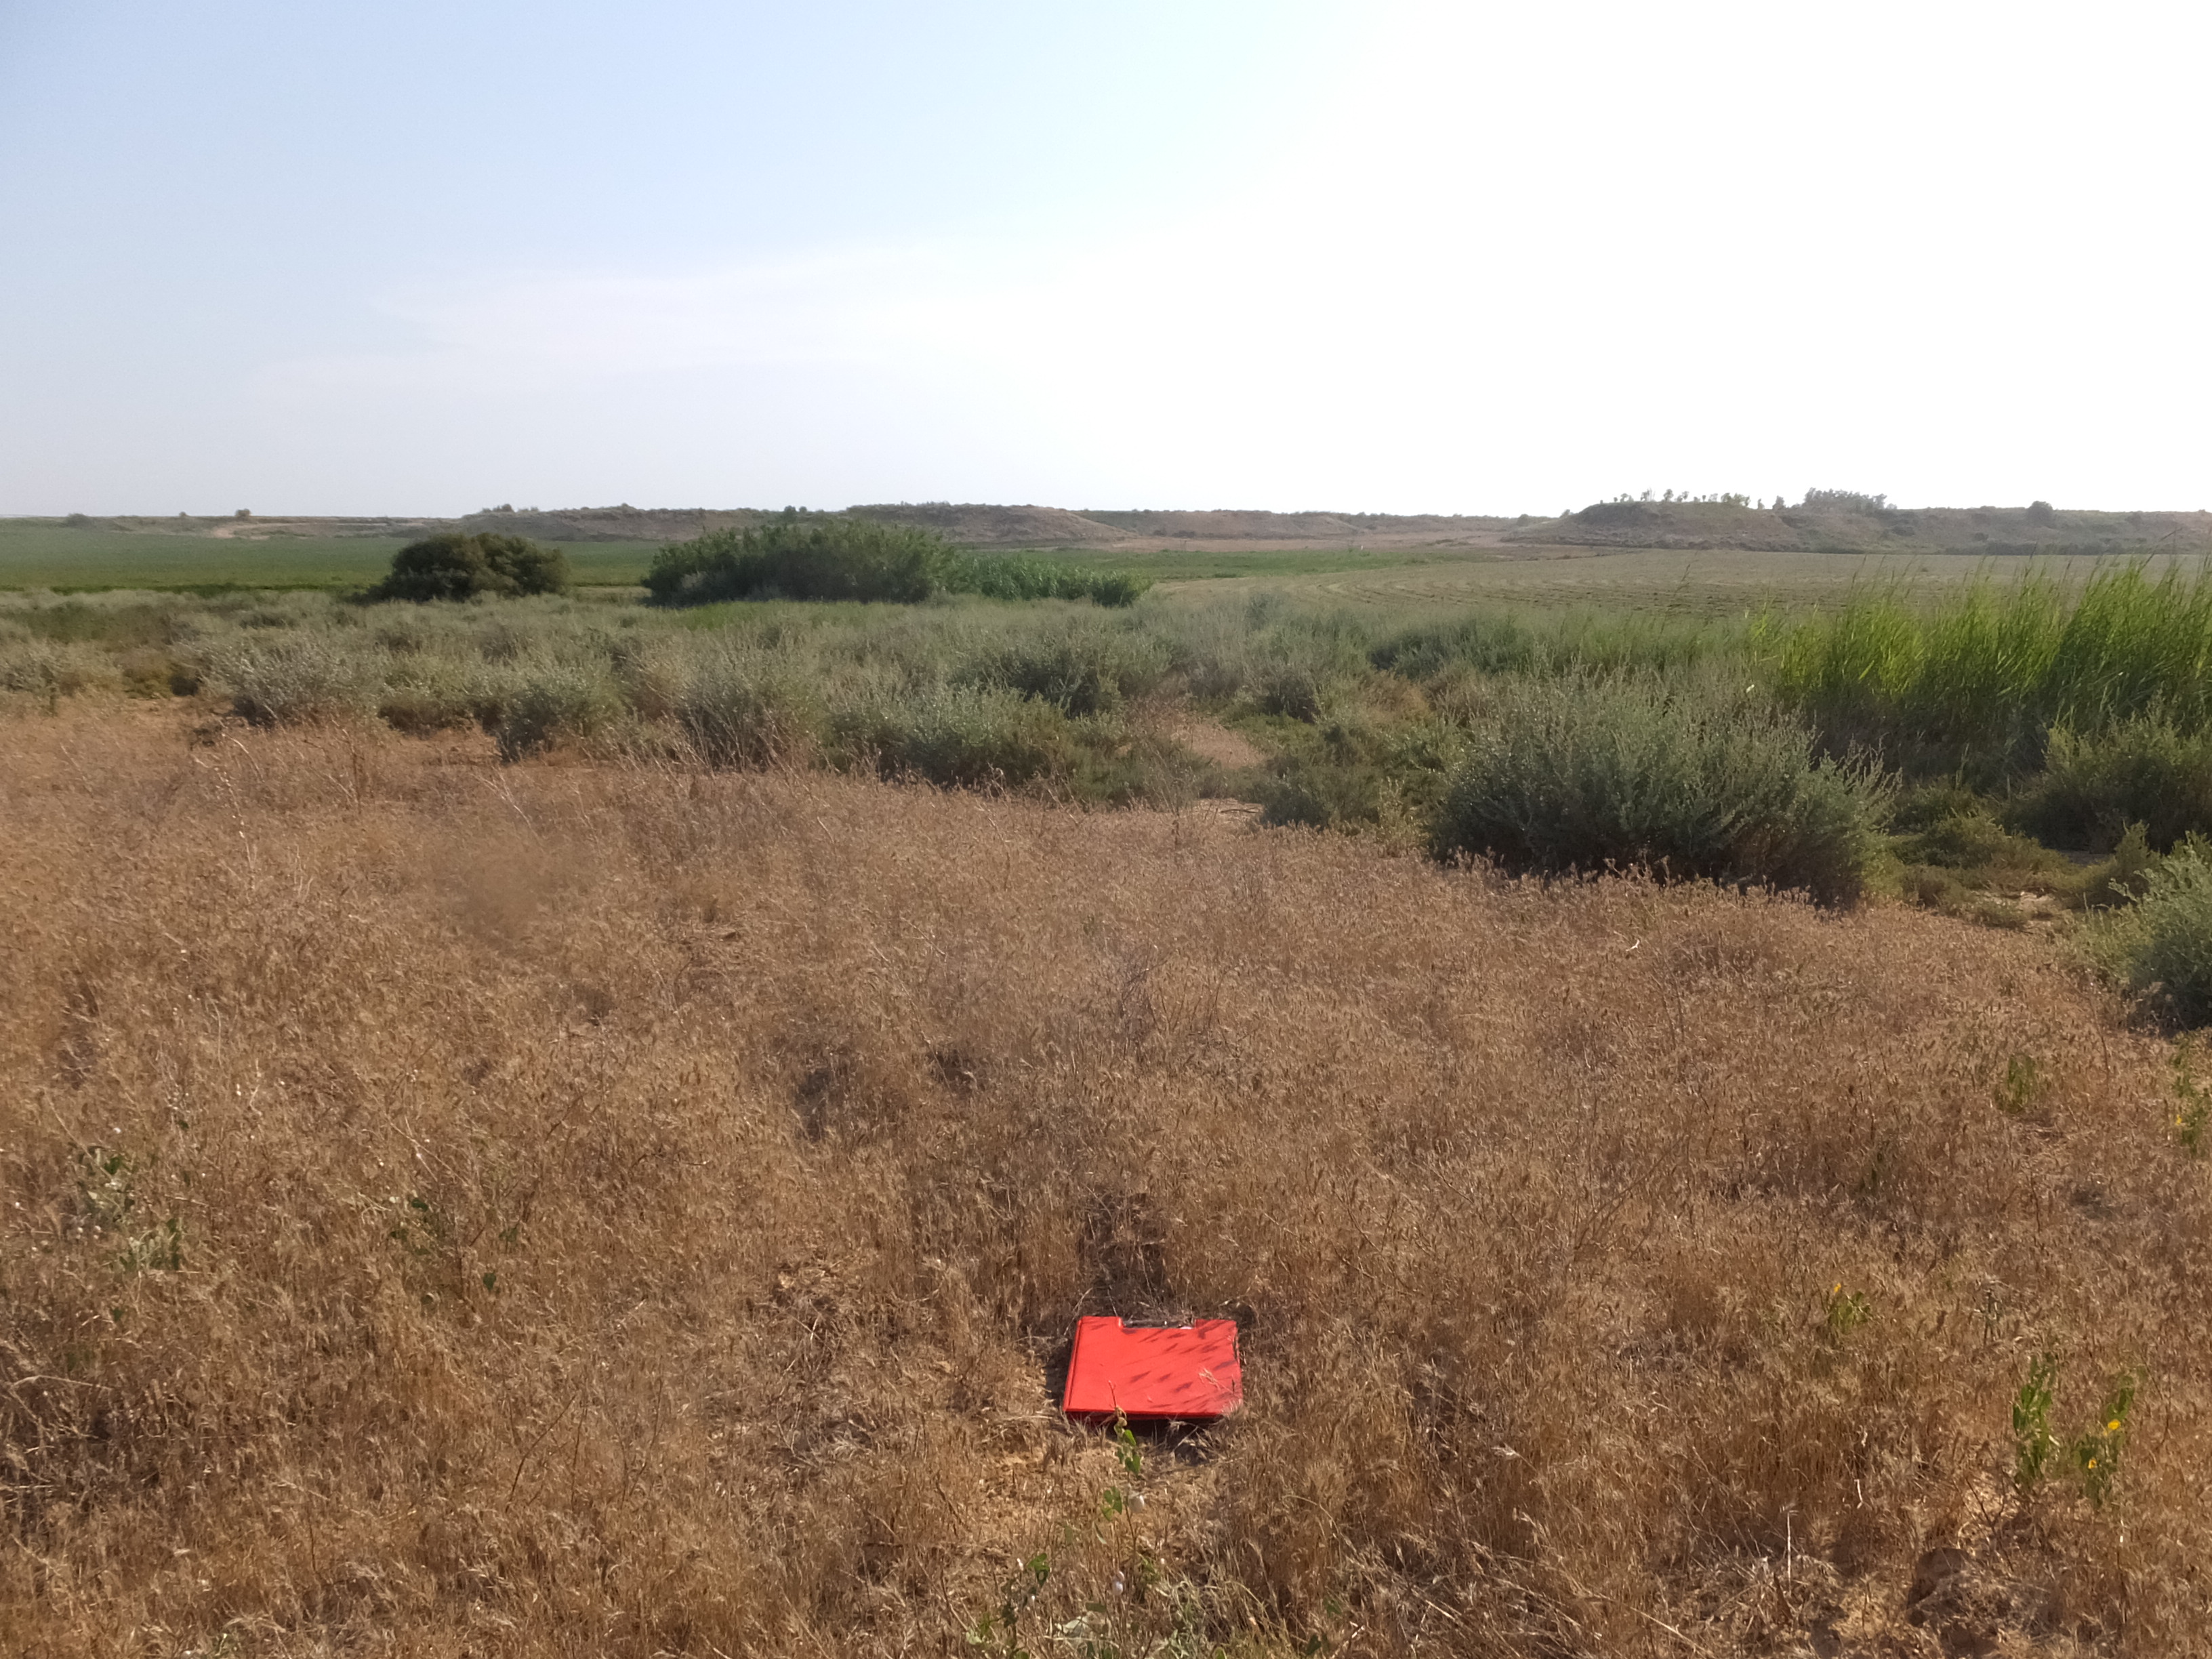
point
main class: Shrubland
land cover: Shrubland without tree cover
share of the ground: 10 - 25 %
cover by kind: herbaceous plants 75 %, shrubs 25 %
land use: Abandoned areas
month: July
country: ES
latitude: 41.7359
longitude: 0.3307
